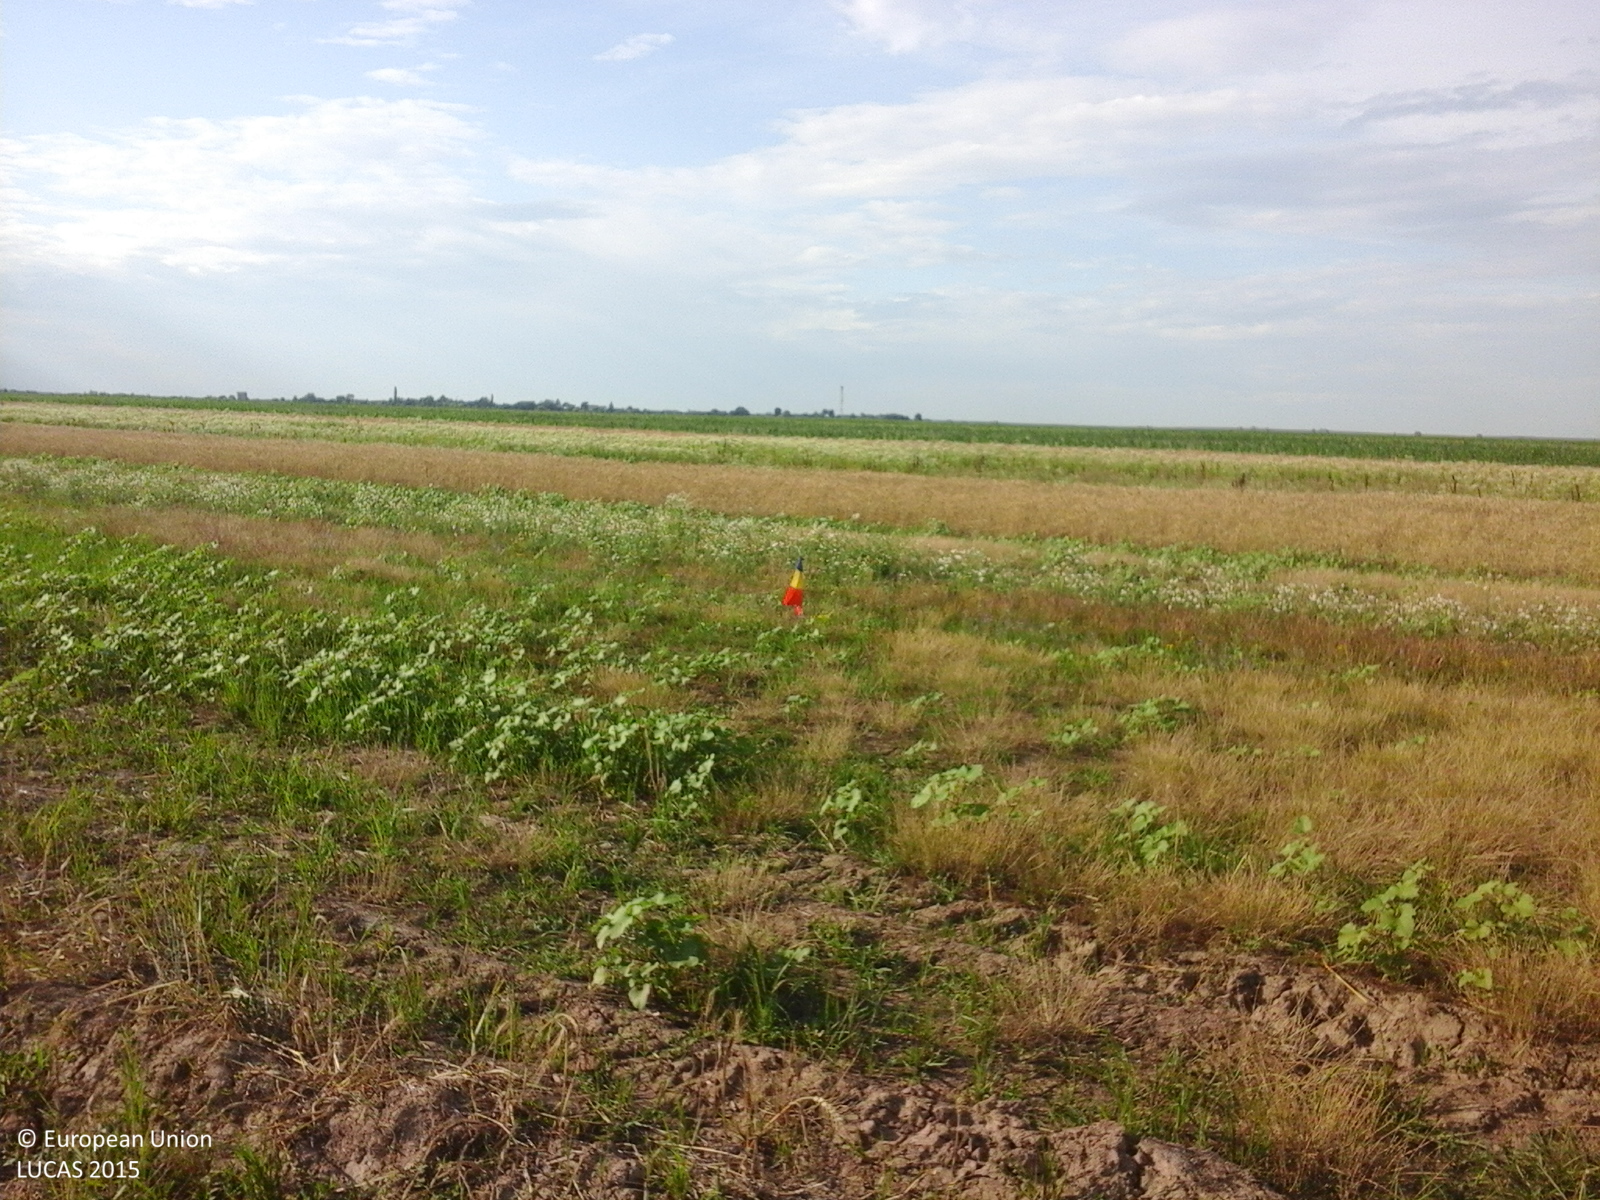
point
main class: Grassland
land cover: Spontaneously vegetated surfaces
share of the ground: < 10 %
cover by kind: herbaceous plants 100 %
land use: Fallow land
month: July
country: RO
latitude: 44.4138
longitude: 25.4489
